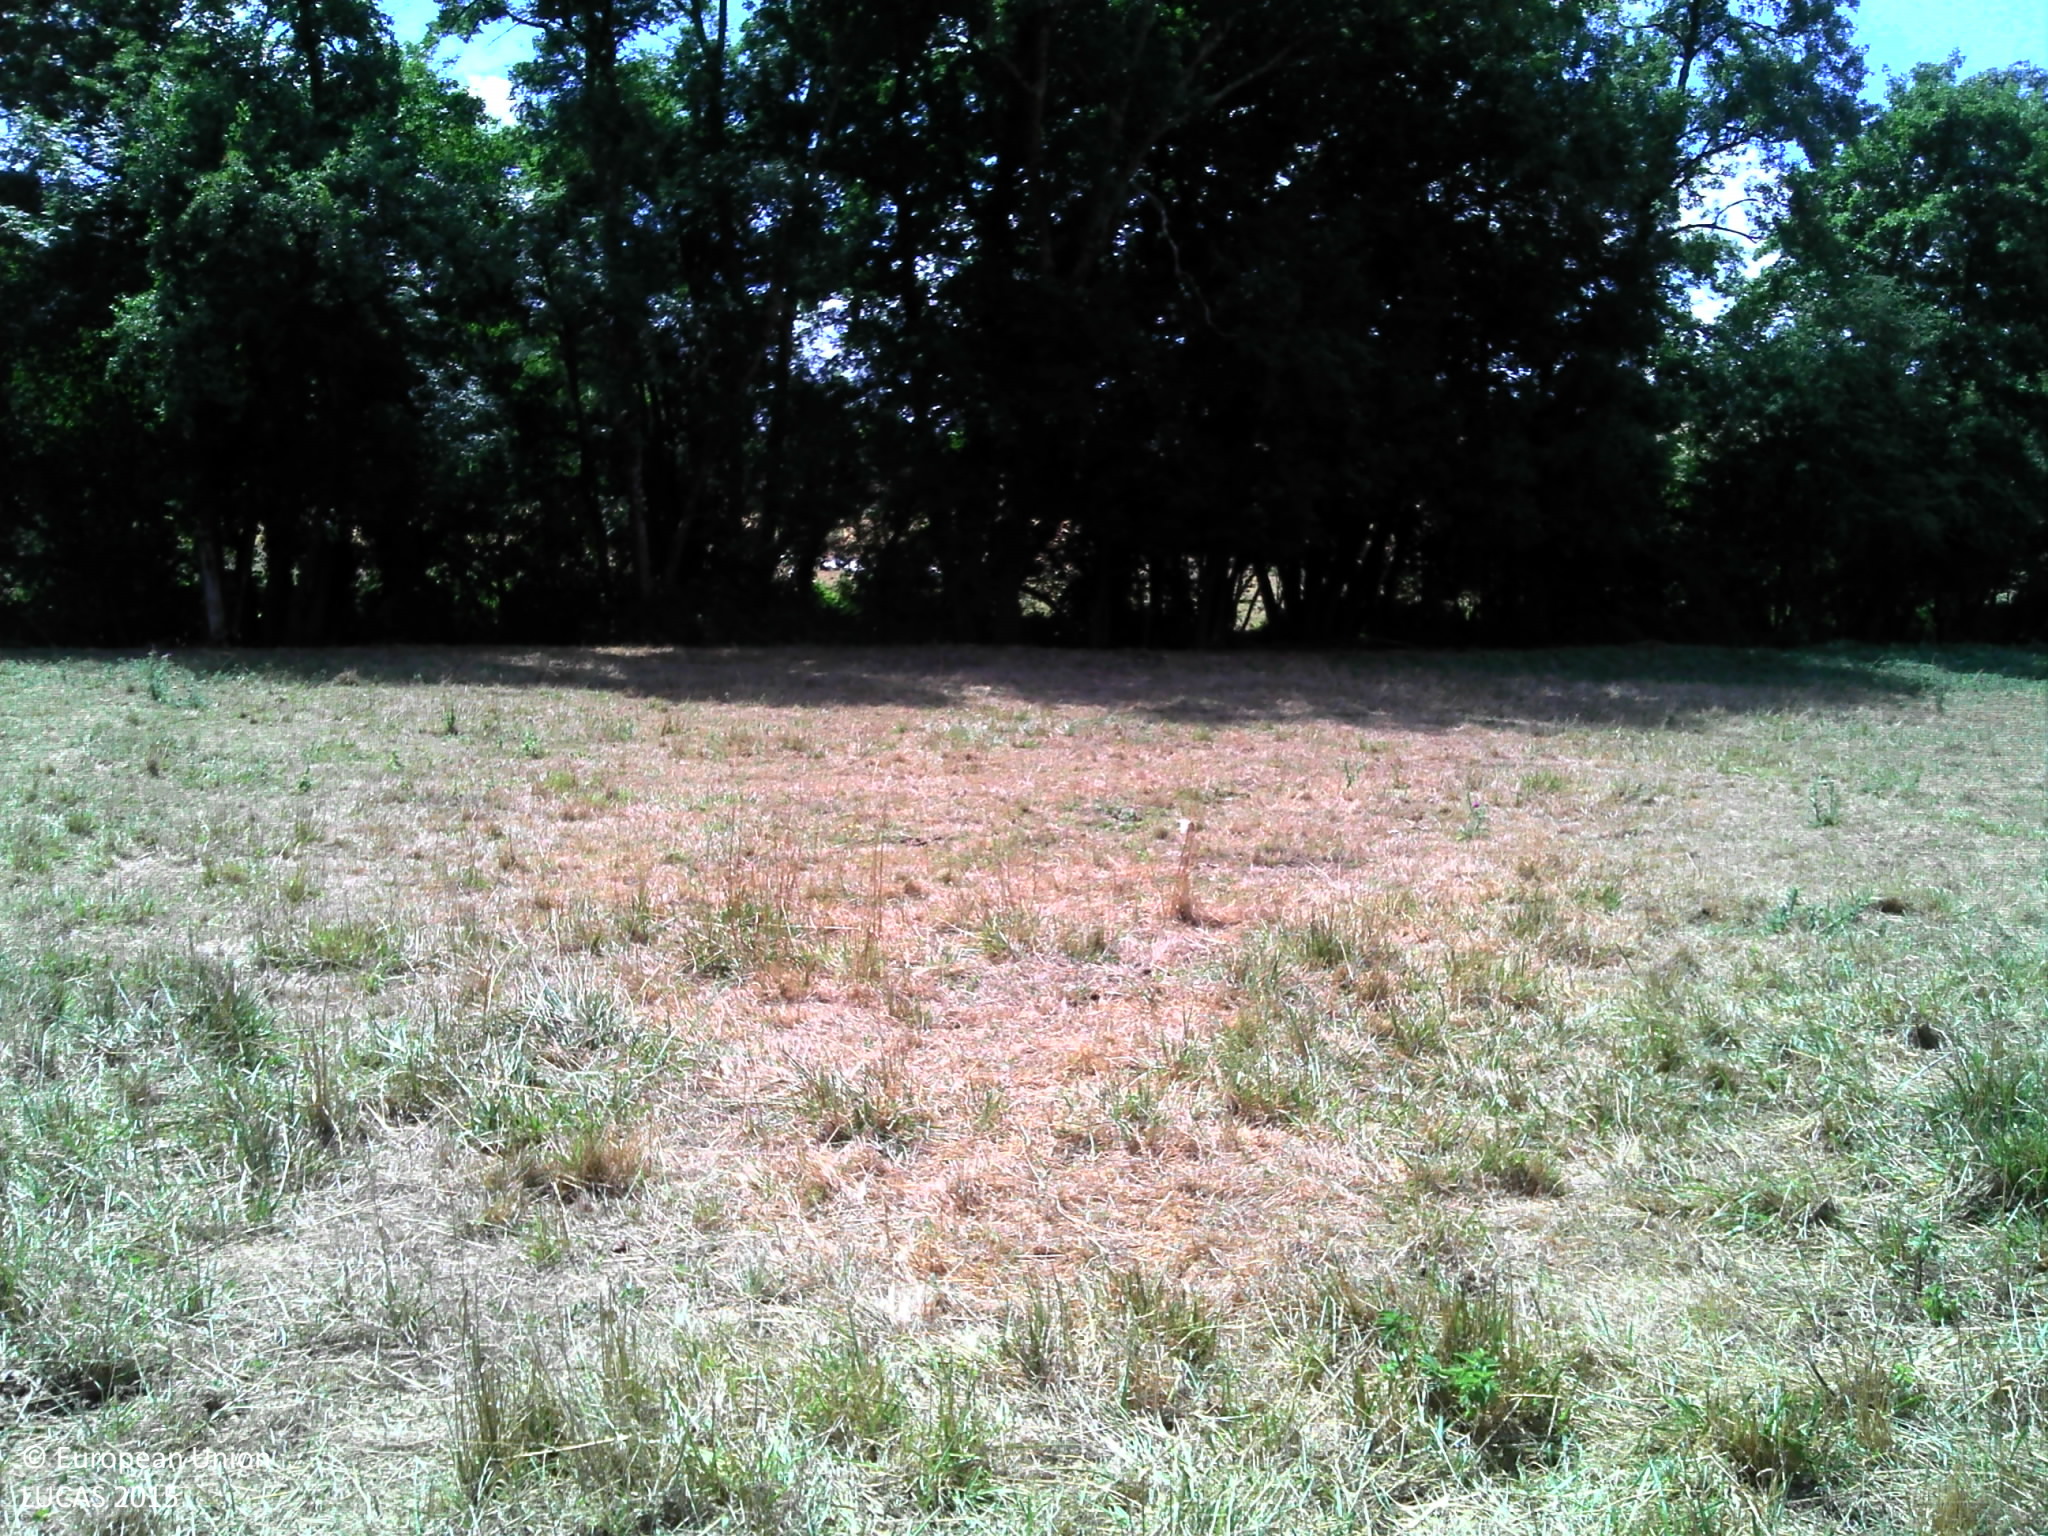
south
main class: Grassland
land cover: Grassland without tree/shrub cover
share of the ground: > 75 %
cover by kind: herbaceous plants 100 %
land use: Agriculture (excluding fallow land and kitchen gardens)
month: July
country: FR
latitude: 47.8651
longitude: 3.1361
